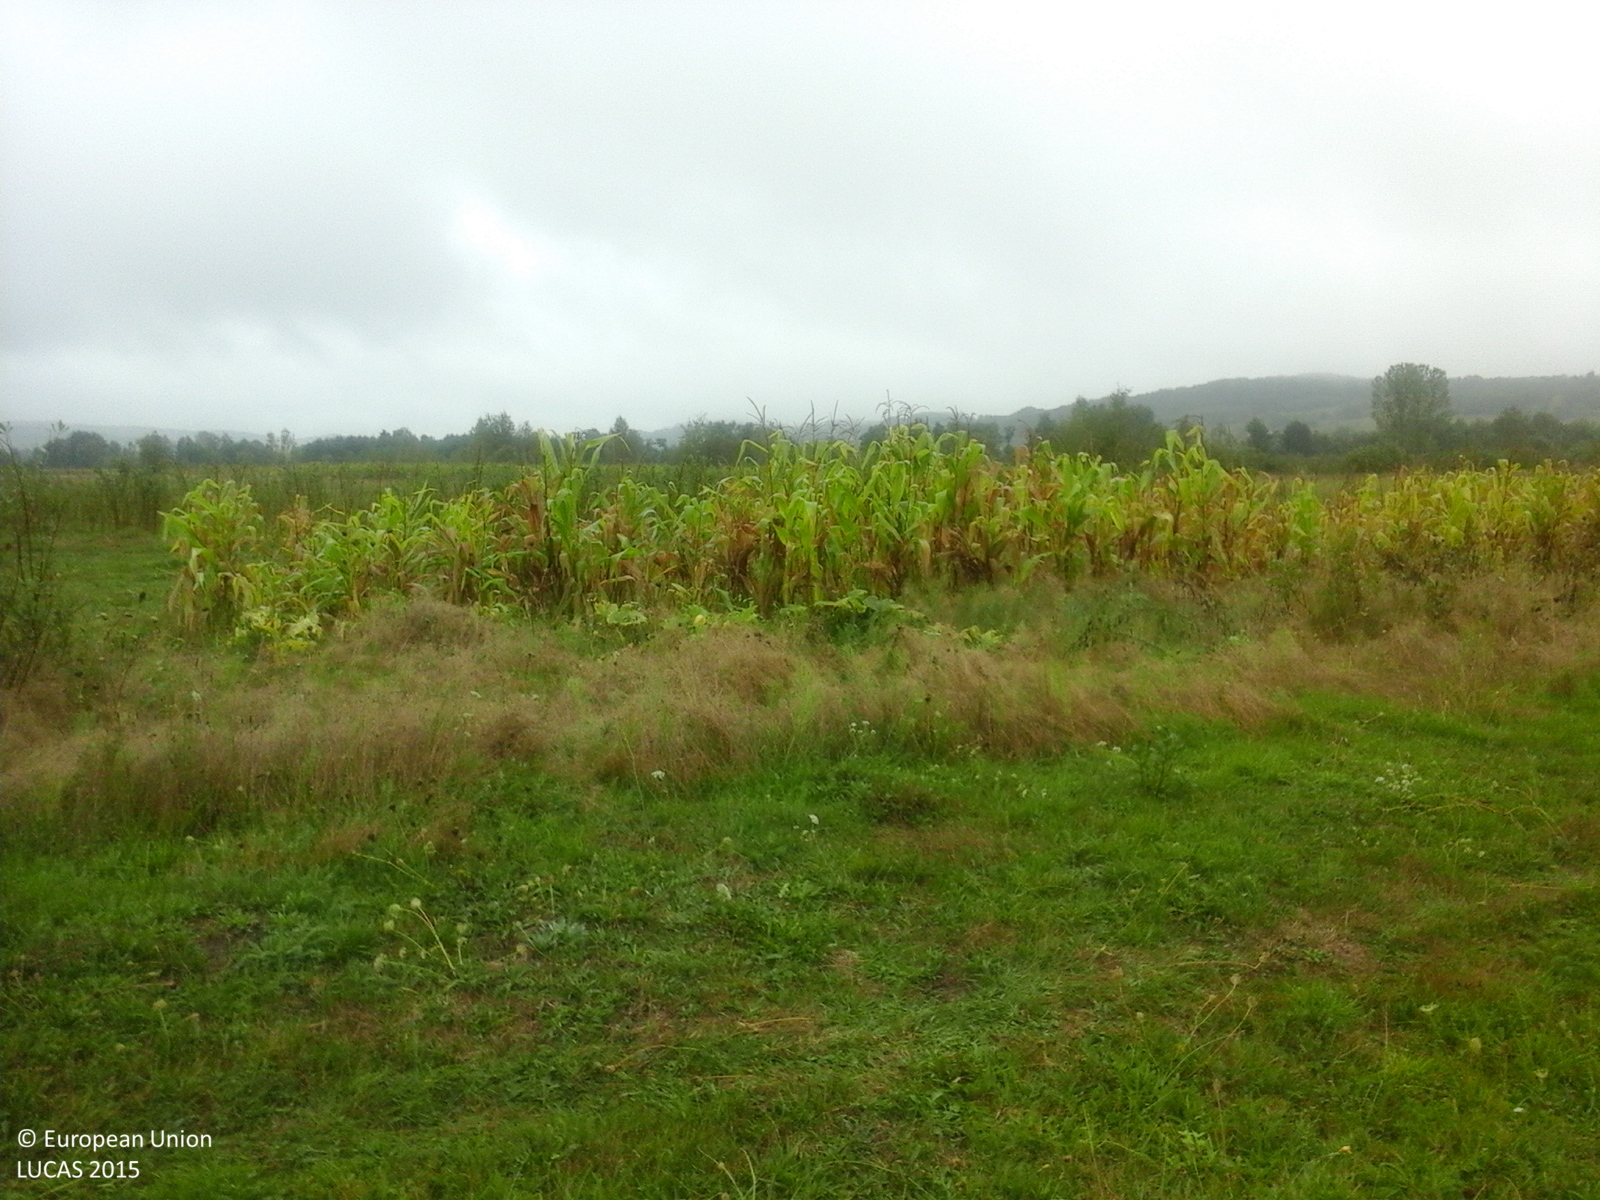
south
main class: Grassland
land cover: Spontaneously vegetated surfaces
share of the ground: > 75 %
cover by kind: herbaceous plants 100 %
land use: Agriculture (excluding fallow land and kitchen gardens)
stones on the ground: < 10 %
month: September
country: RO
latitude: 45.1363
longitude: 23.8356
